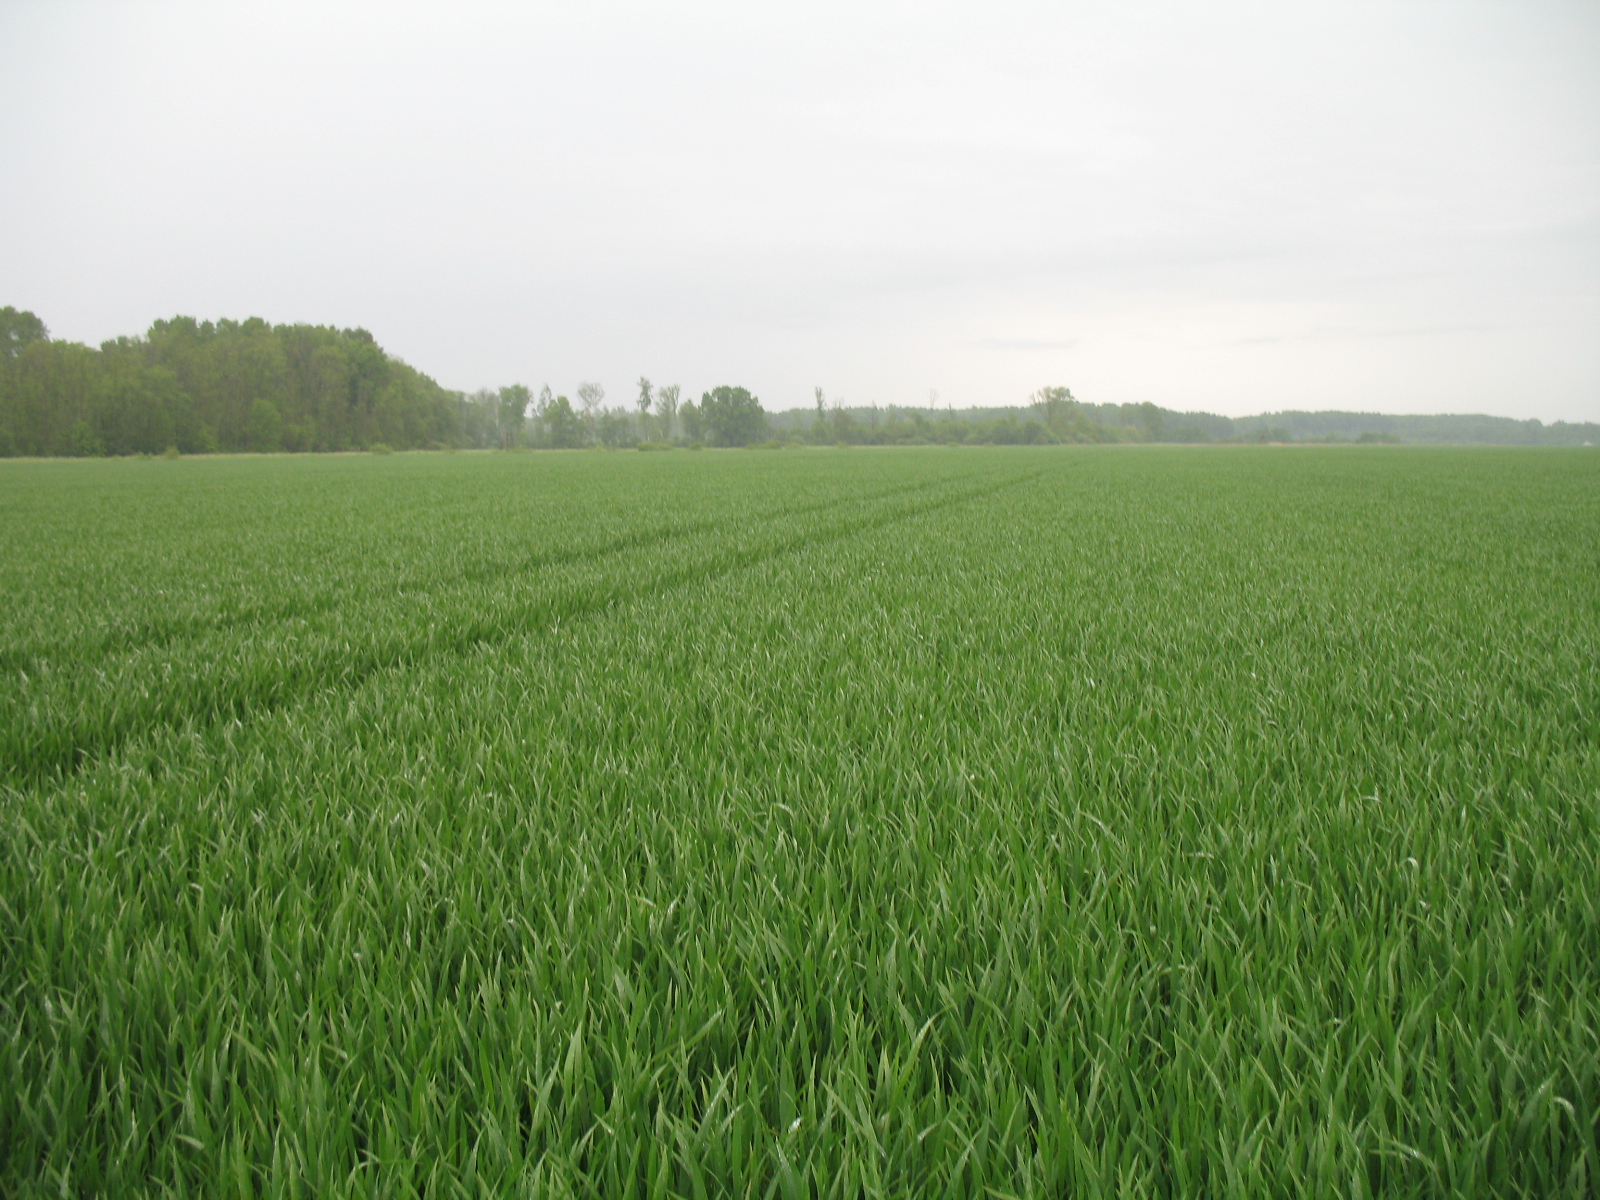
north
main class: Cropland
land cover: Common wheat
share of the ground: > 75 %
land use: Agriculture (excluding fallow land and kitchen gardens)
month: May
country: LV
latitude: 56.7308
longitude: 23.4930
